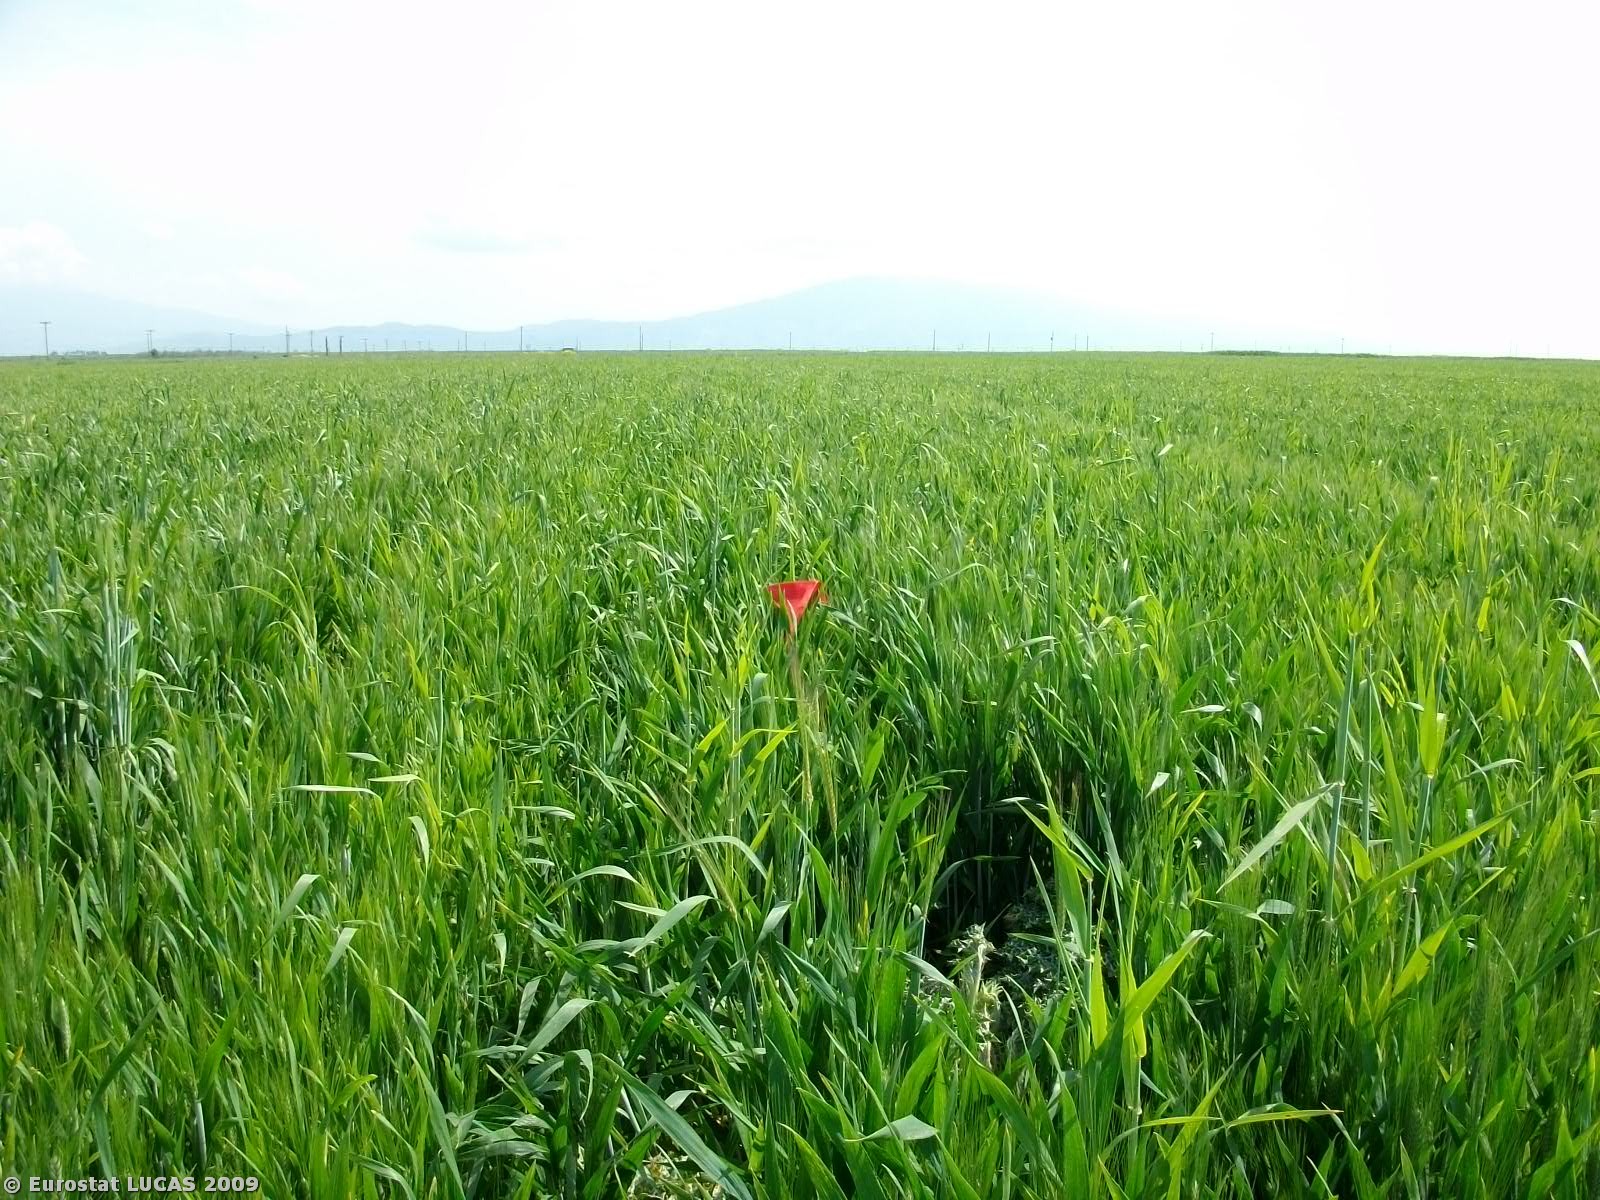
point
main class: Cropland
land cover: Durum wheat
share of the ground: > 75 %
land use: Agriculture (excluding fallow land and kitchen gardens)
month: April
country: GR
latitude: 39.5291
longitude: 22.5660
